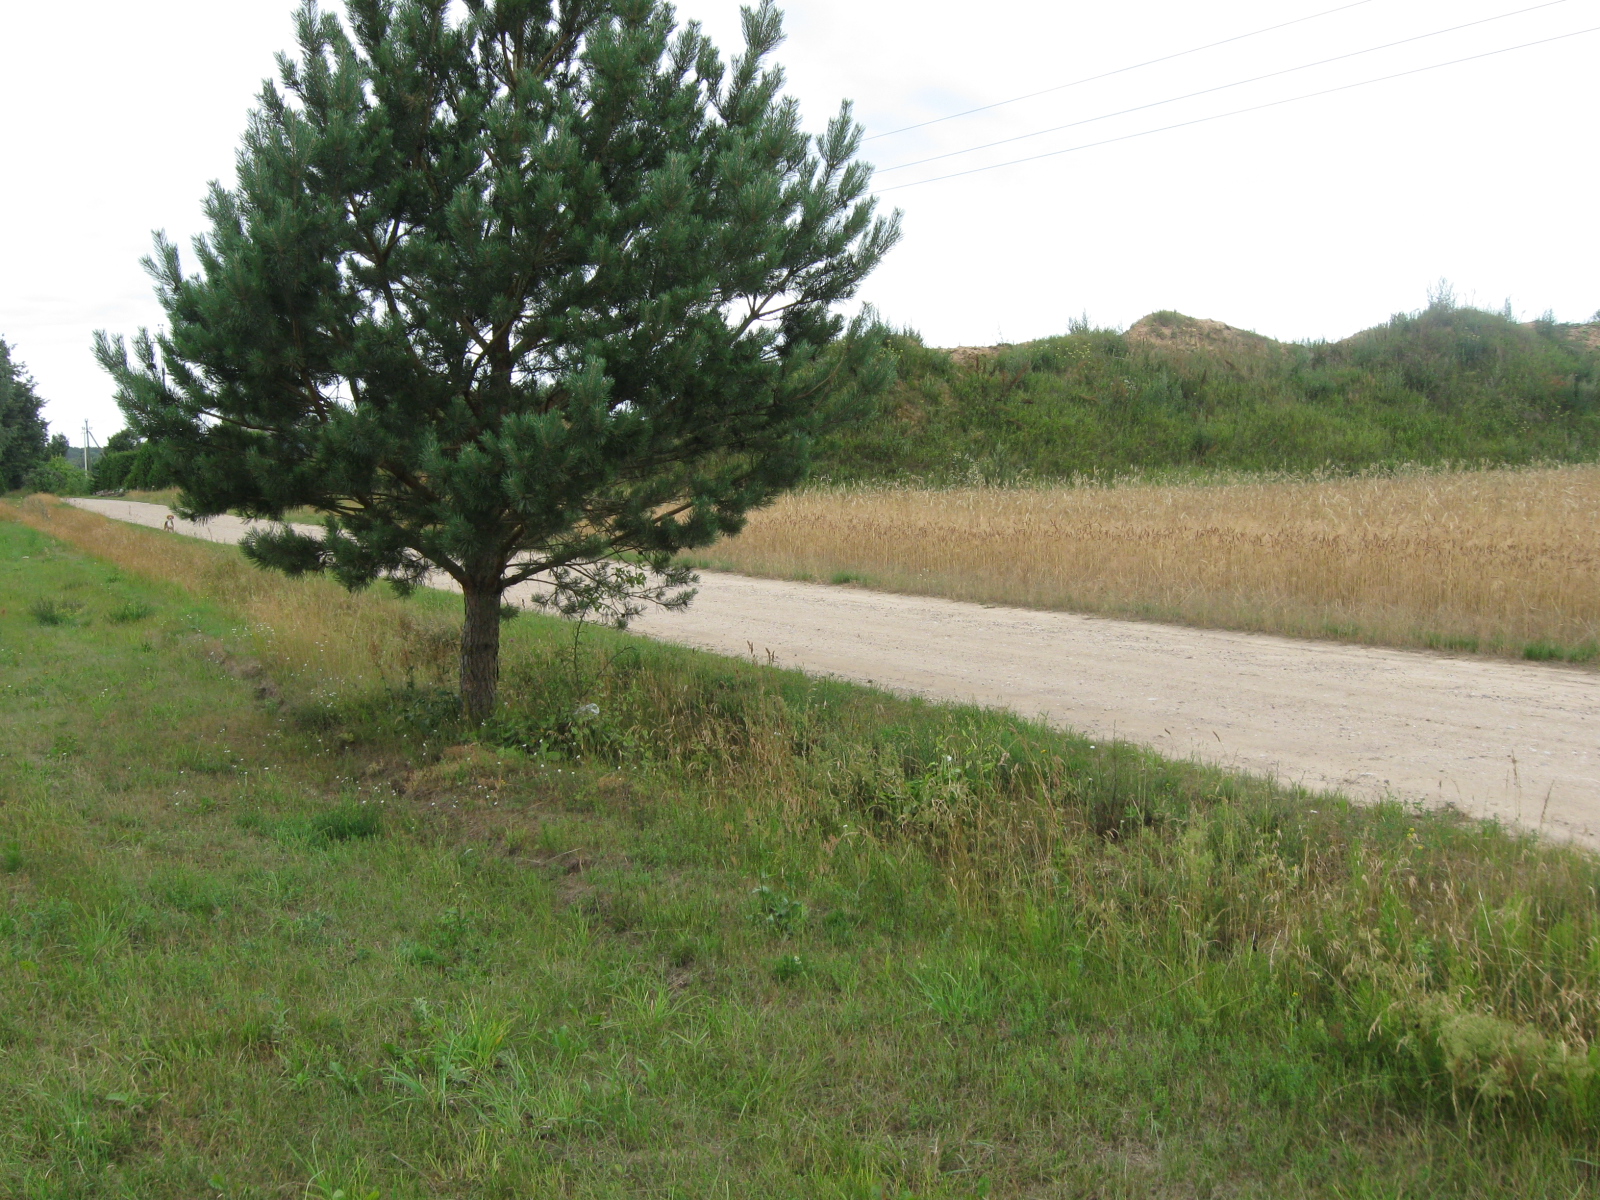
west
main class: Grassland
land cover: Grassland without tree/shrub cover
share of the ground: > 75 %
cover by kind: herbaceous plants 90 %, unconsolidated bare surface 10 %
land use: Agriculture (excluding fallow land and kitchen gardens)
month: July
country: LT
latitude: 55.0128
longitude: 23.6734
